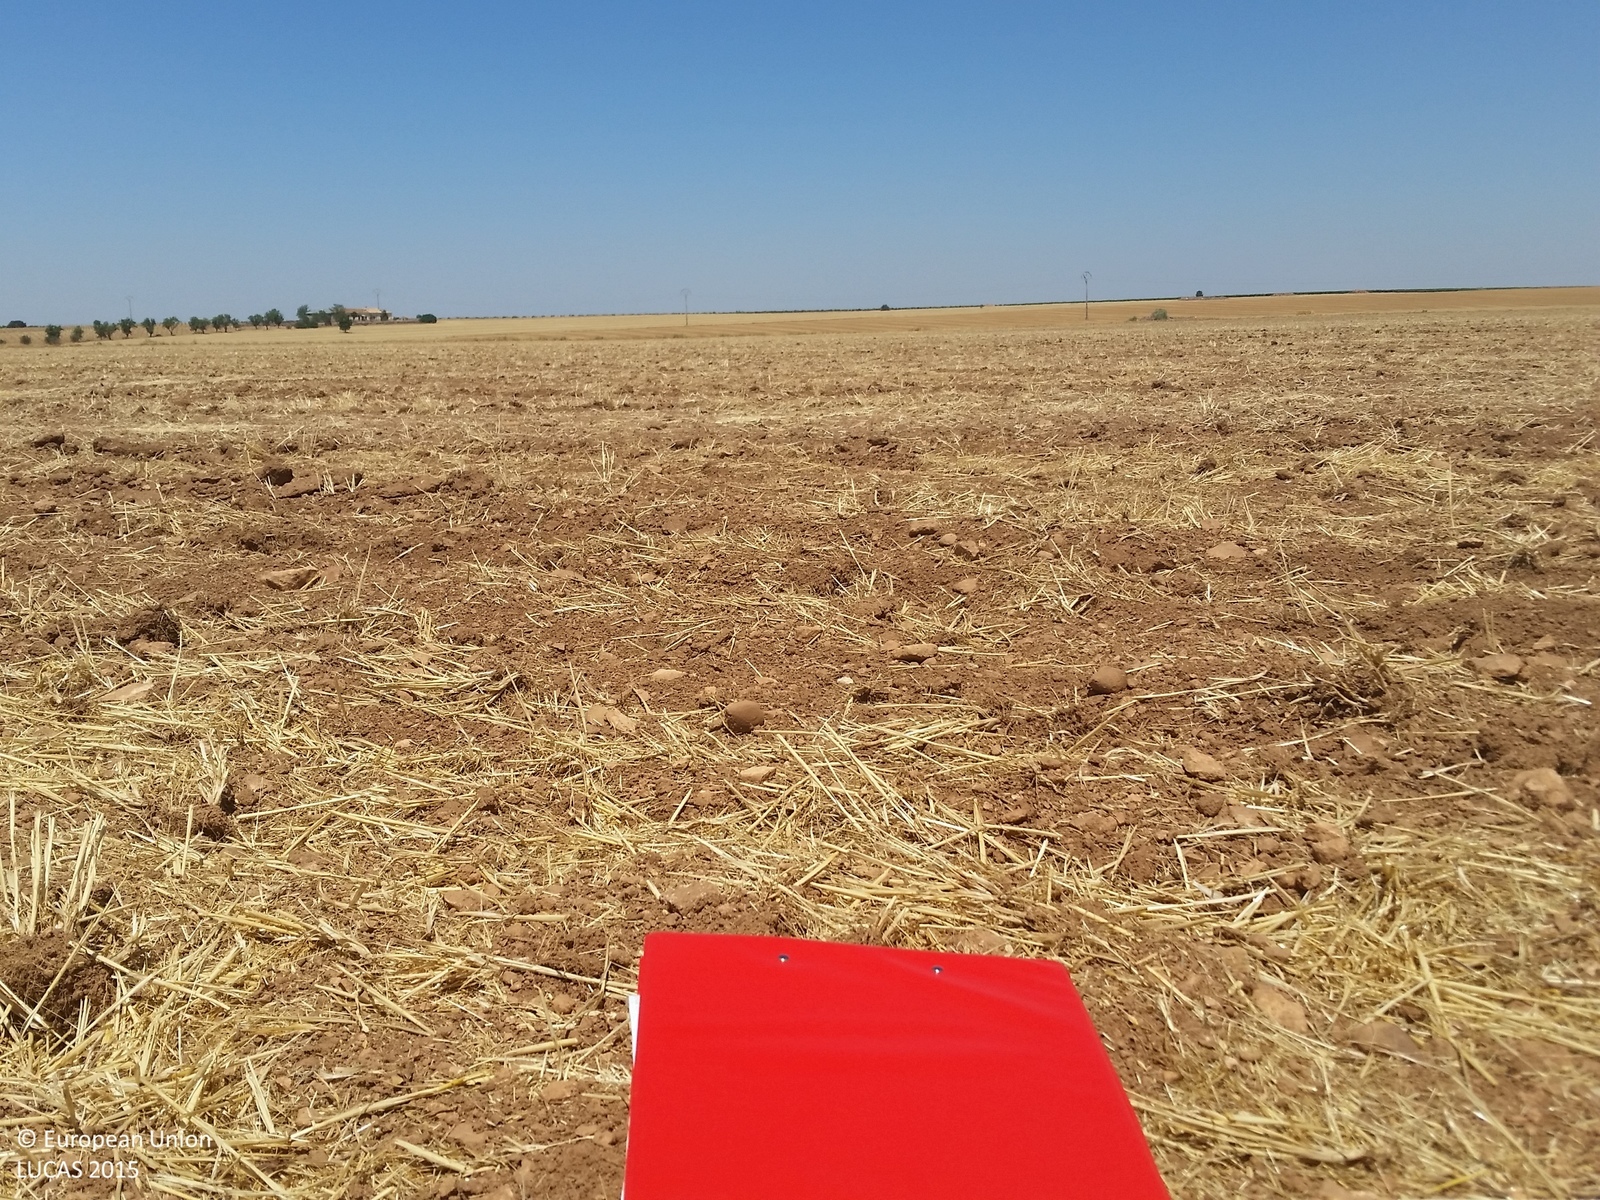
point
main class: Cropland
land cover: Barley
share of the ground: < 10 %
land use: Agriculture (excluding fallow land and kitchen gardens)
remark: Harvested field
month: July
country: ES
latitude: 39.1633
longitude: -2.5654
